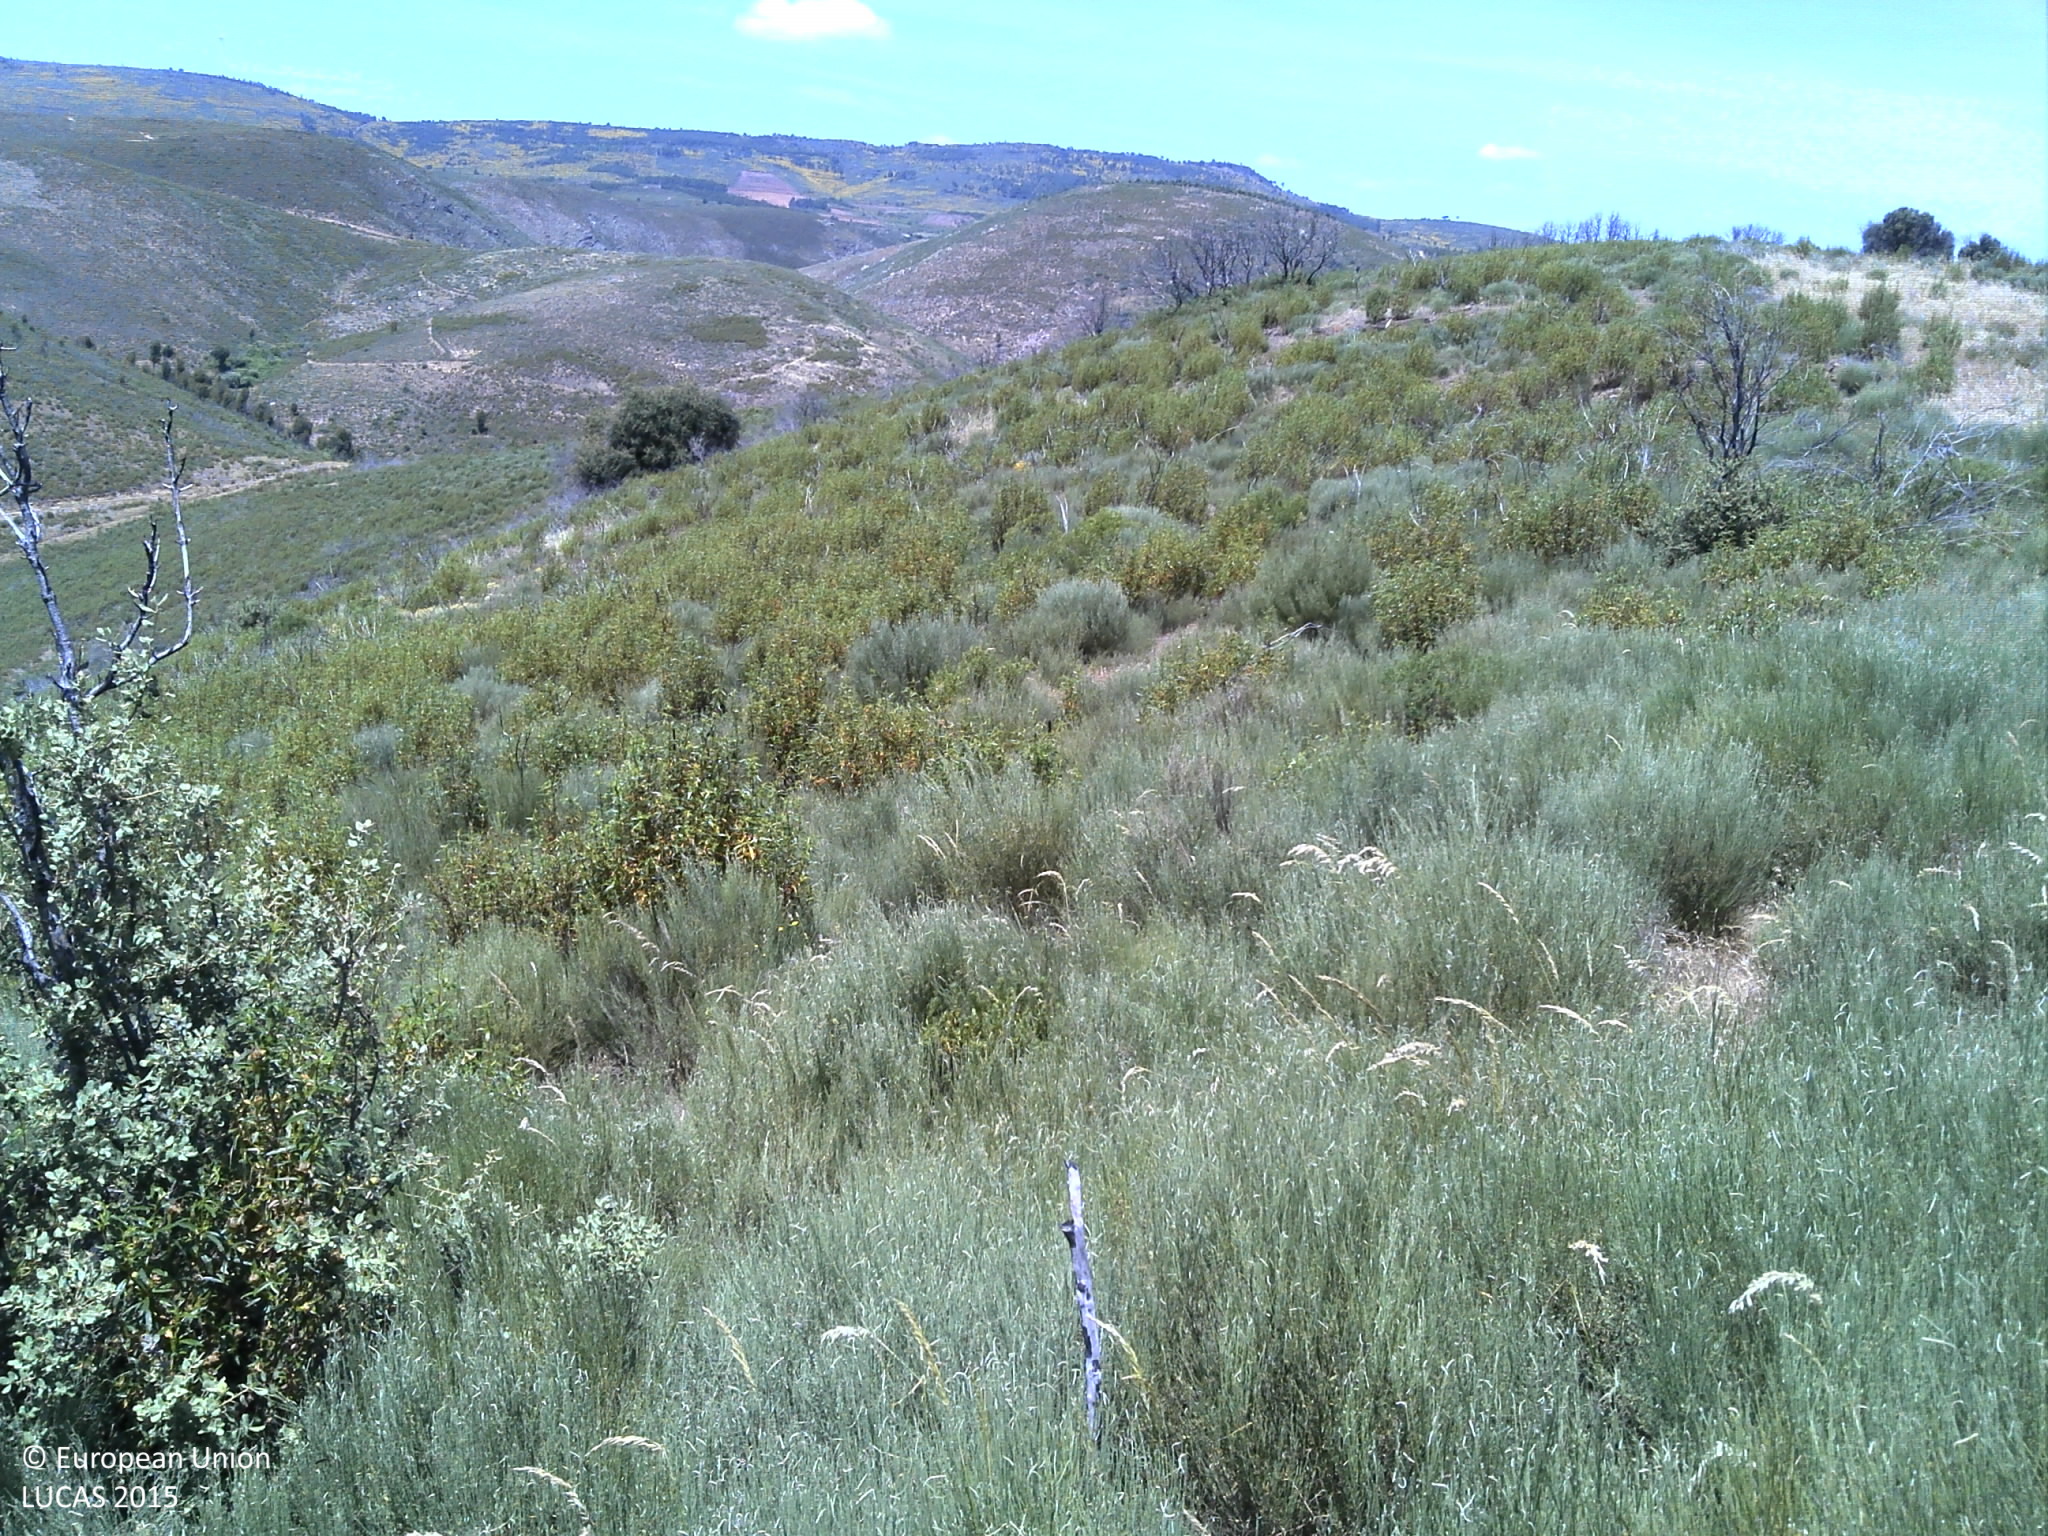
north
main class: Shrubland
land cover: Shrubland with sparse tree cover
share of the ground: 50 - 75 %
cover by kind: shrubs 75 %, herbaceous plants 10 %, unconsolidated bare surface 10 %, broadleaved forest trees 5 %
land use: Abandoned areas
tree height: < 5 m
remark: Burnt area
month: May
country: PT
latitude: 41.1409
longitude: -6.9420
